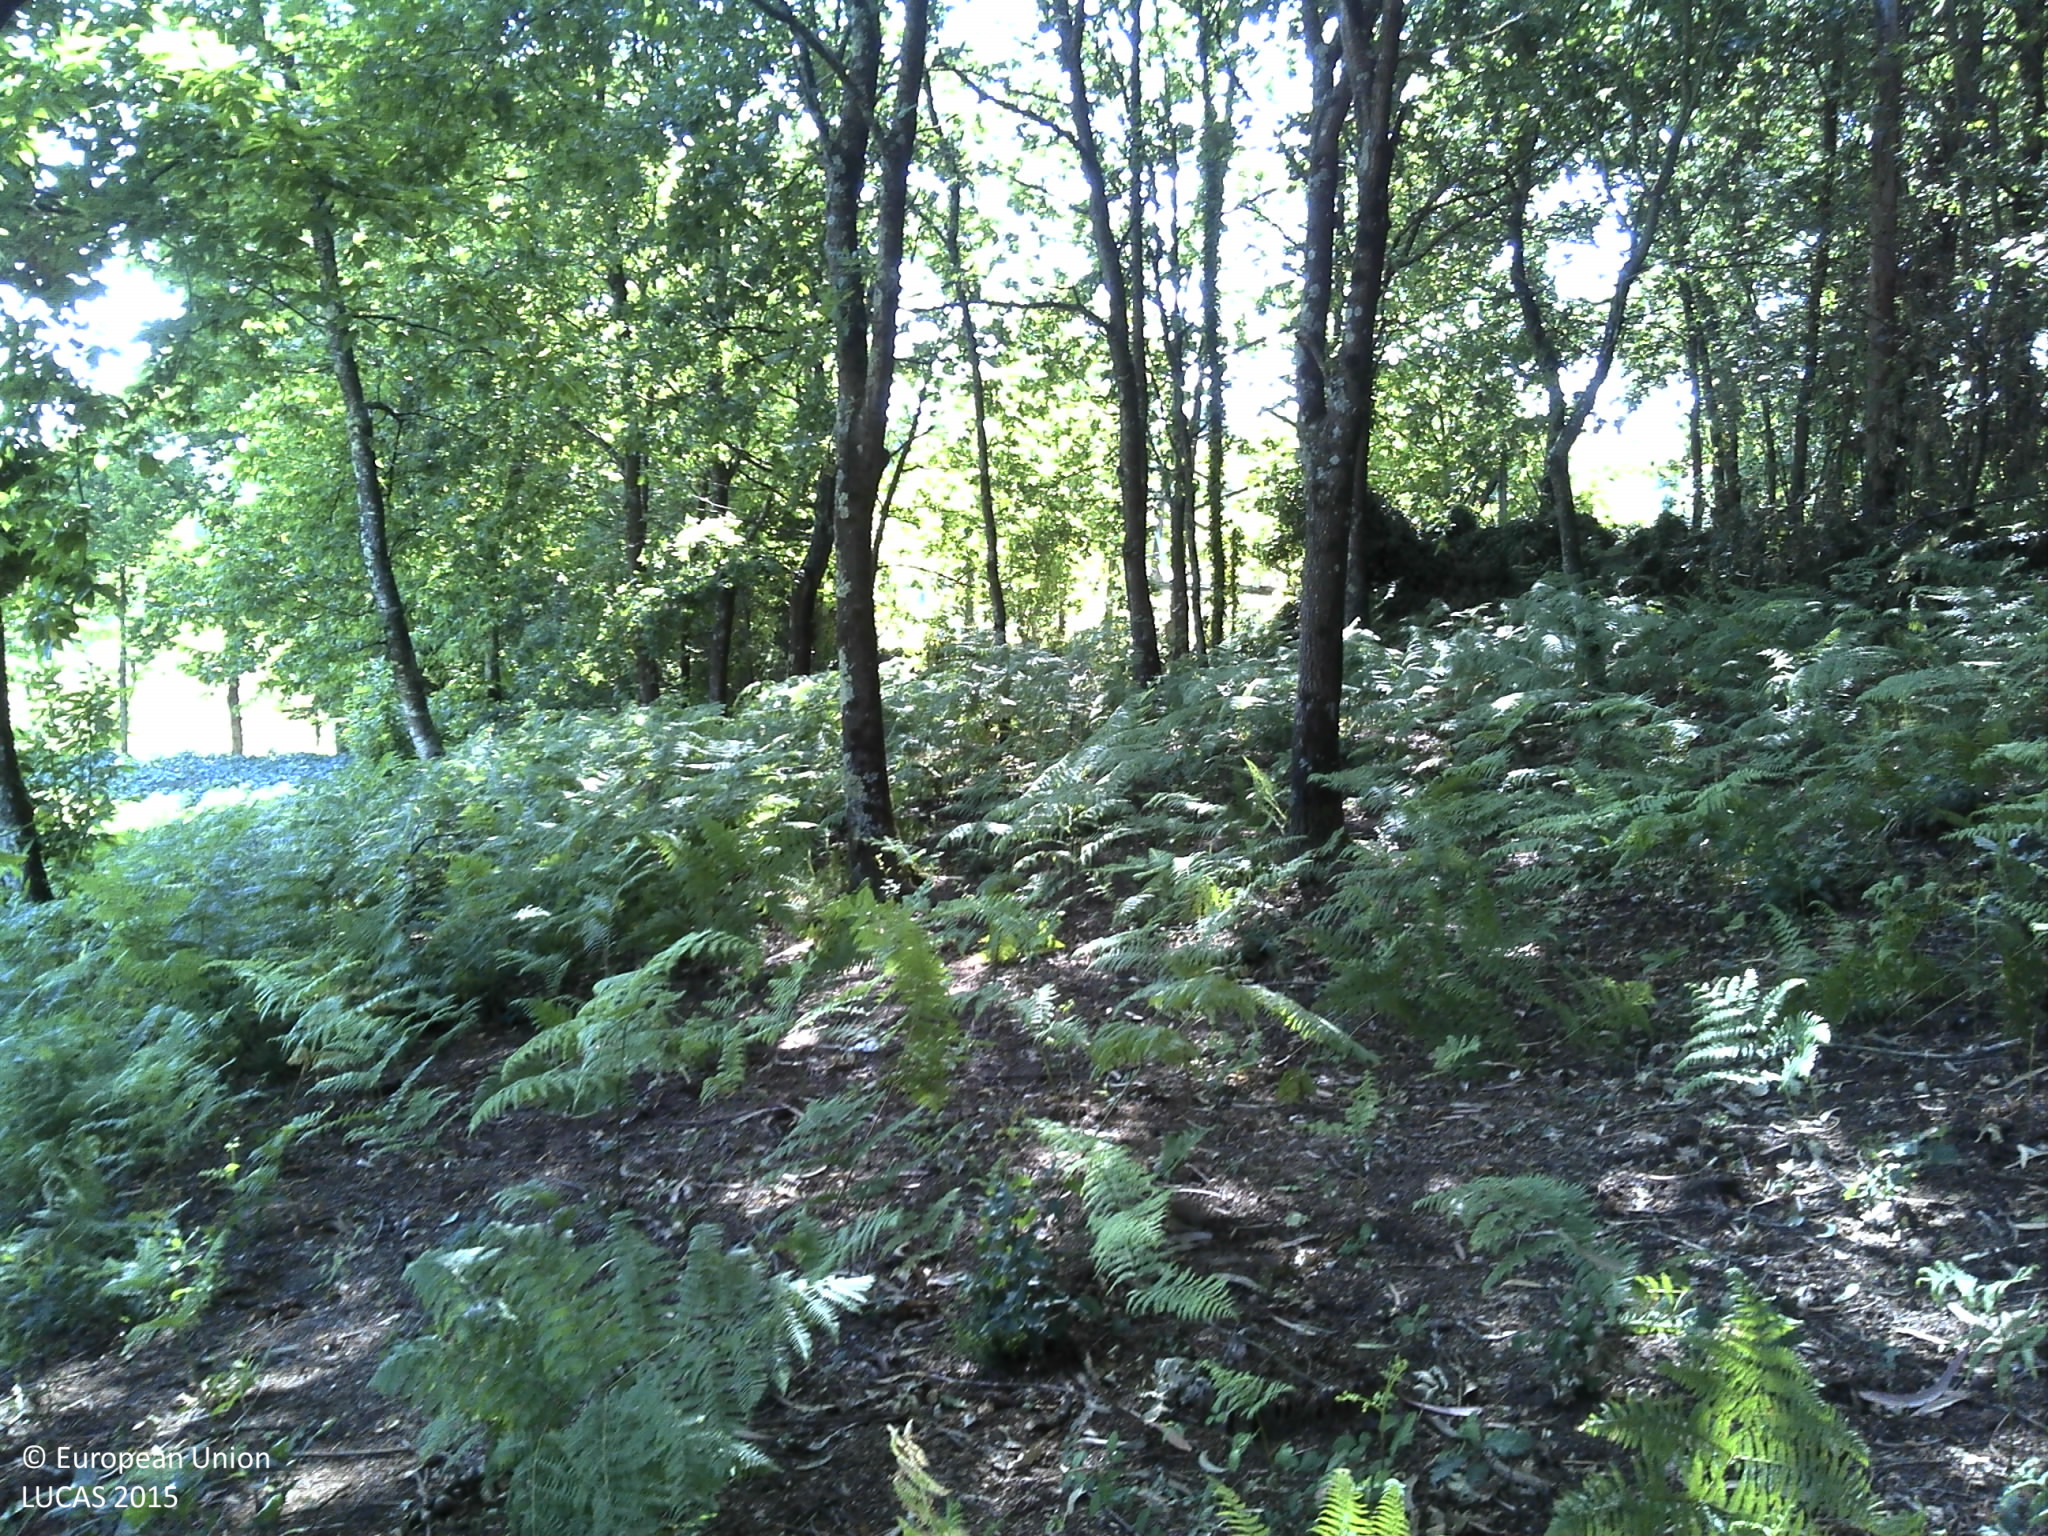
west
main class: Woodland
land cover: Broadleaved woodland
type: acidophilous oak and oak-birch forest
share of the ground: 50 - 75 %
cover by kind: broadleaved forest trees 60 %, unconsolidated bare surface 30 %, herbaceous plants 10 %
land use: Forestry
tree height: > 5 m
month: May
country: PT
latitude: 41.4663
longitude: -8.3126
